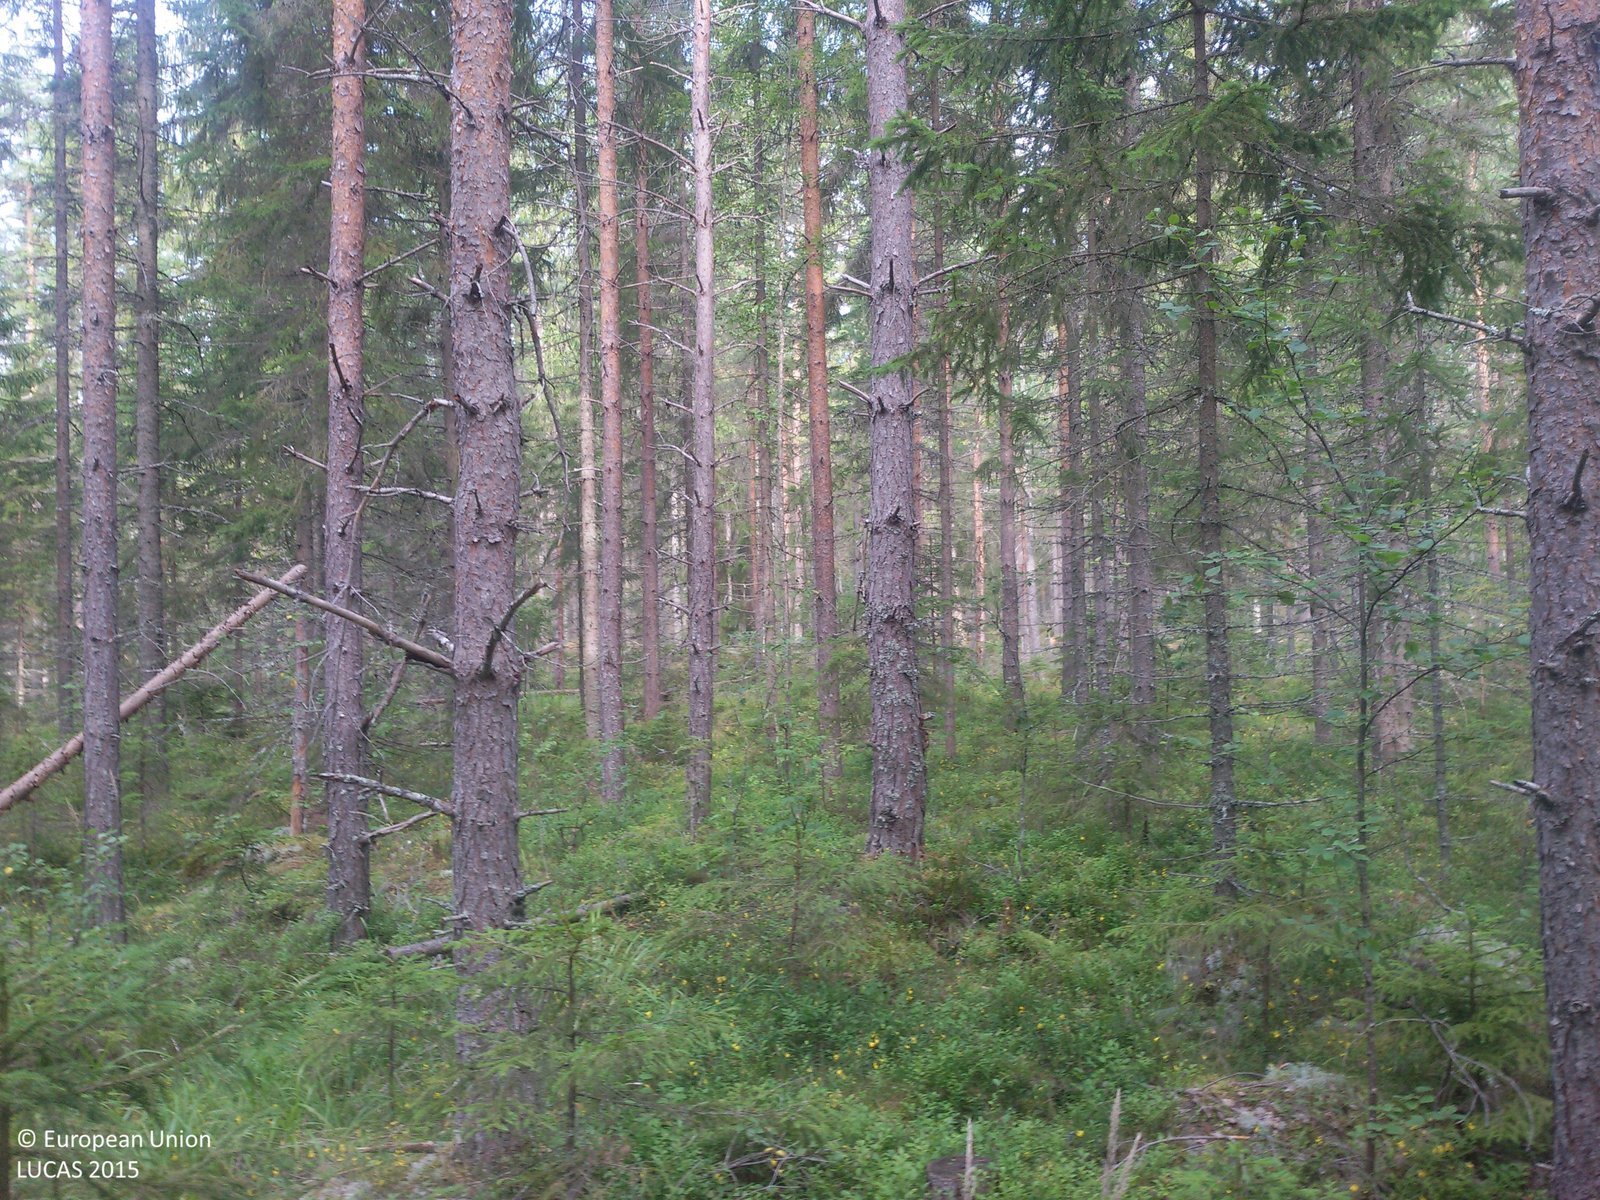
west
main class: Woodland
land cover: Spruce dominated coniferous woodland
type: boreal forest
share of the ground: > 75 %
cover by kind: coniferous forest trees 75 %, shrubs 15 %, herbaceous plants 5 %, lichens and mosses 5 %
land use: Forestry
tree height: > 5 m
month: August
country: SE
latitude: 60.6299
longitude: 16.4403
